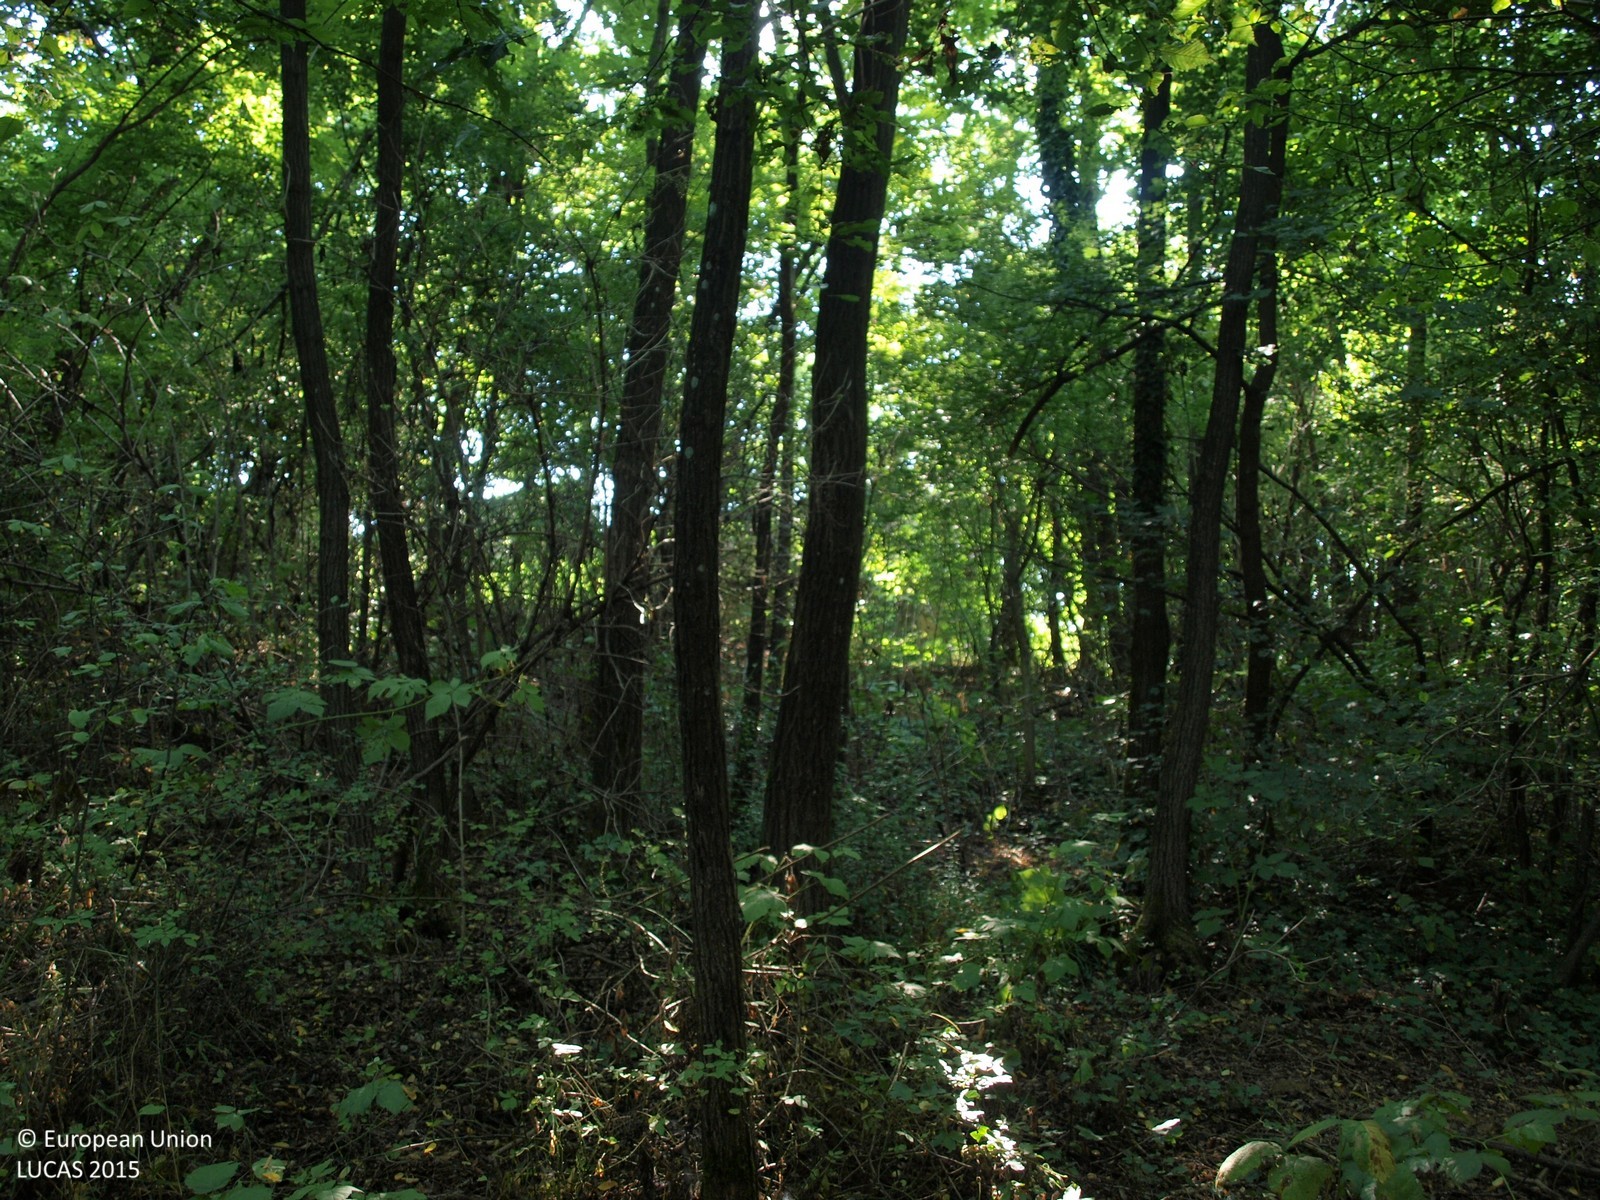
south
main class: Woodland
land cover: Broadleaved woodland
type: mesophytic deciduous forest
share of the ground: > 75 %
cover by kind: broadleaved forest trees 100 %
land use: Forestry
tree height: > 5 m
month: August
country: HR
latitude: 46.0856
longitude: 16.4272
